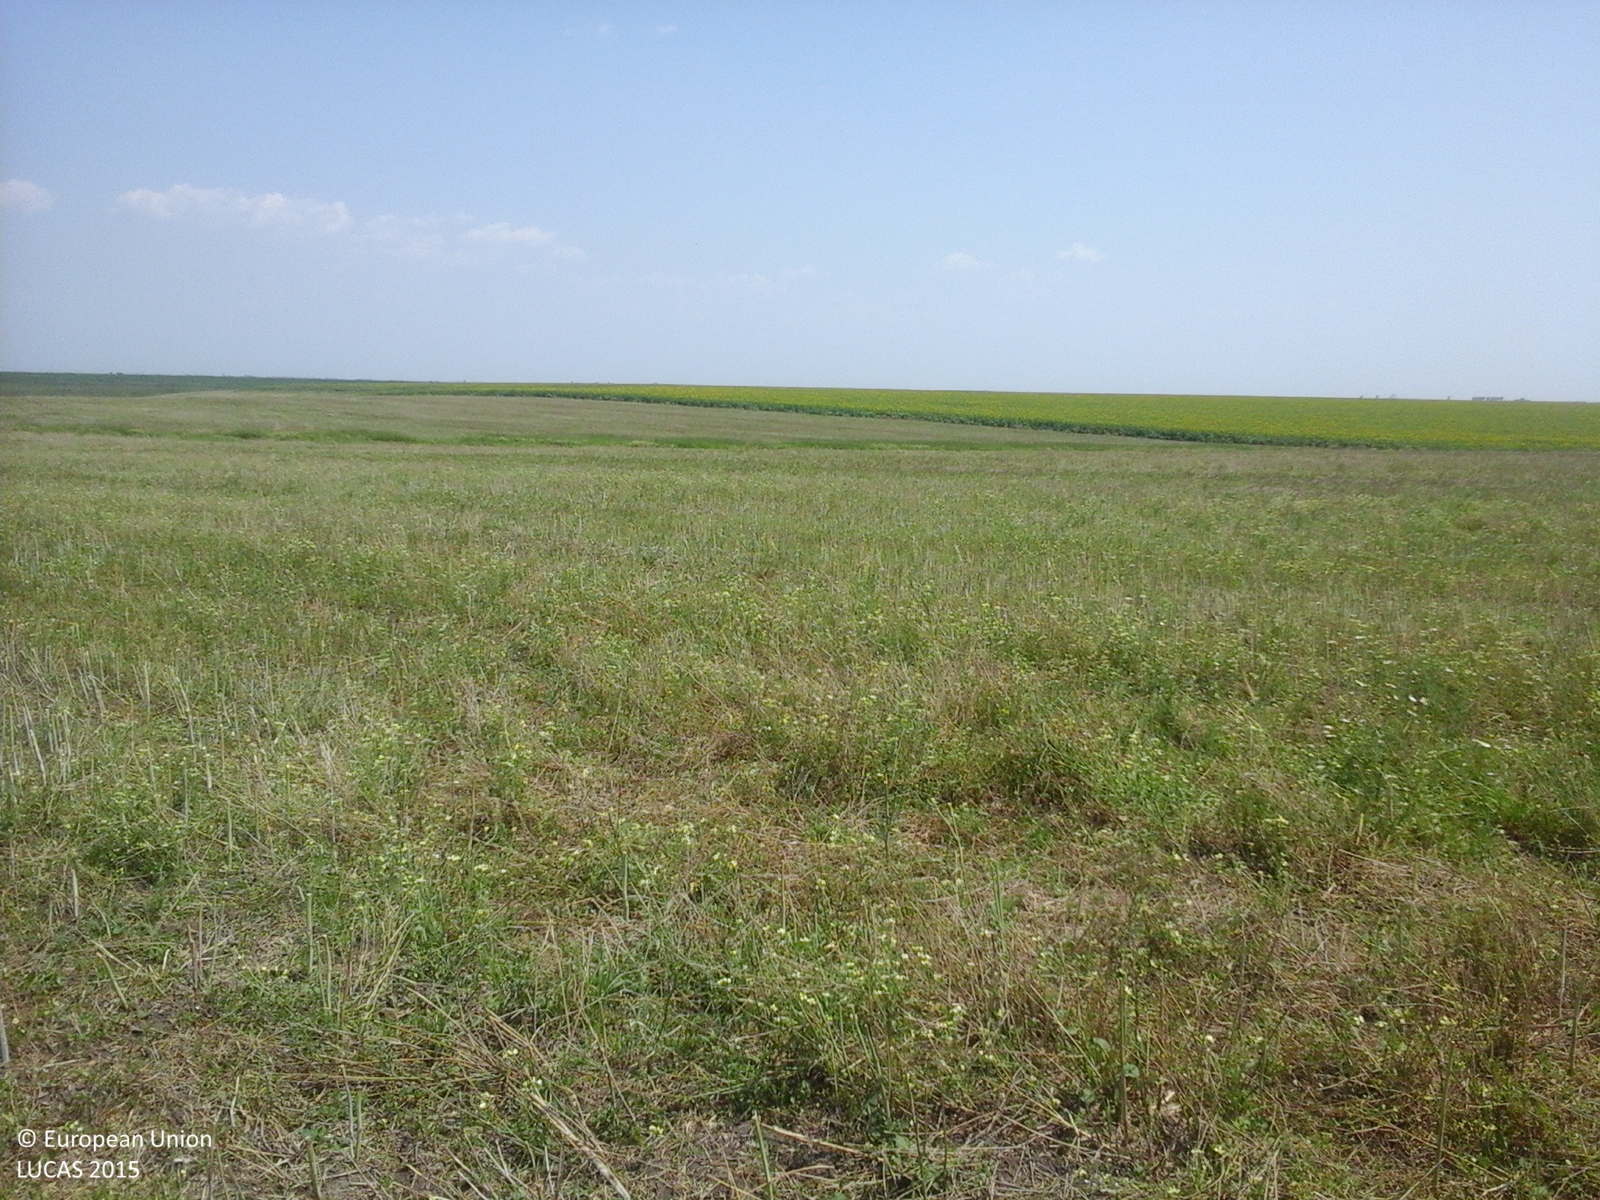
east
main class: Cropland
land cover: Rape and turnip rape
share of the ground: < 10 %
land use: Agriculture (excluding fallow land and kitchen gardens)
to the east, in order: Rape and turnip rape
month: July
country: RO
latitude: 44.5187
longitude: 24.8610
